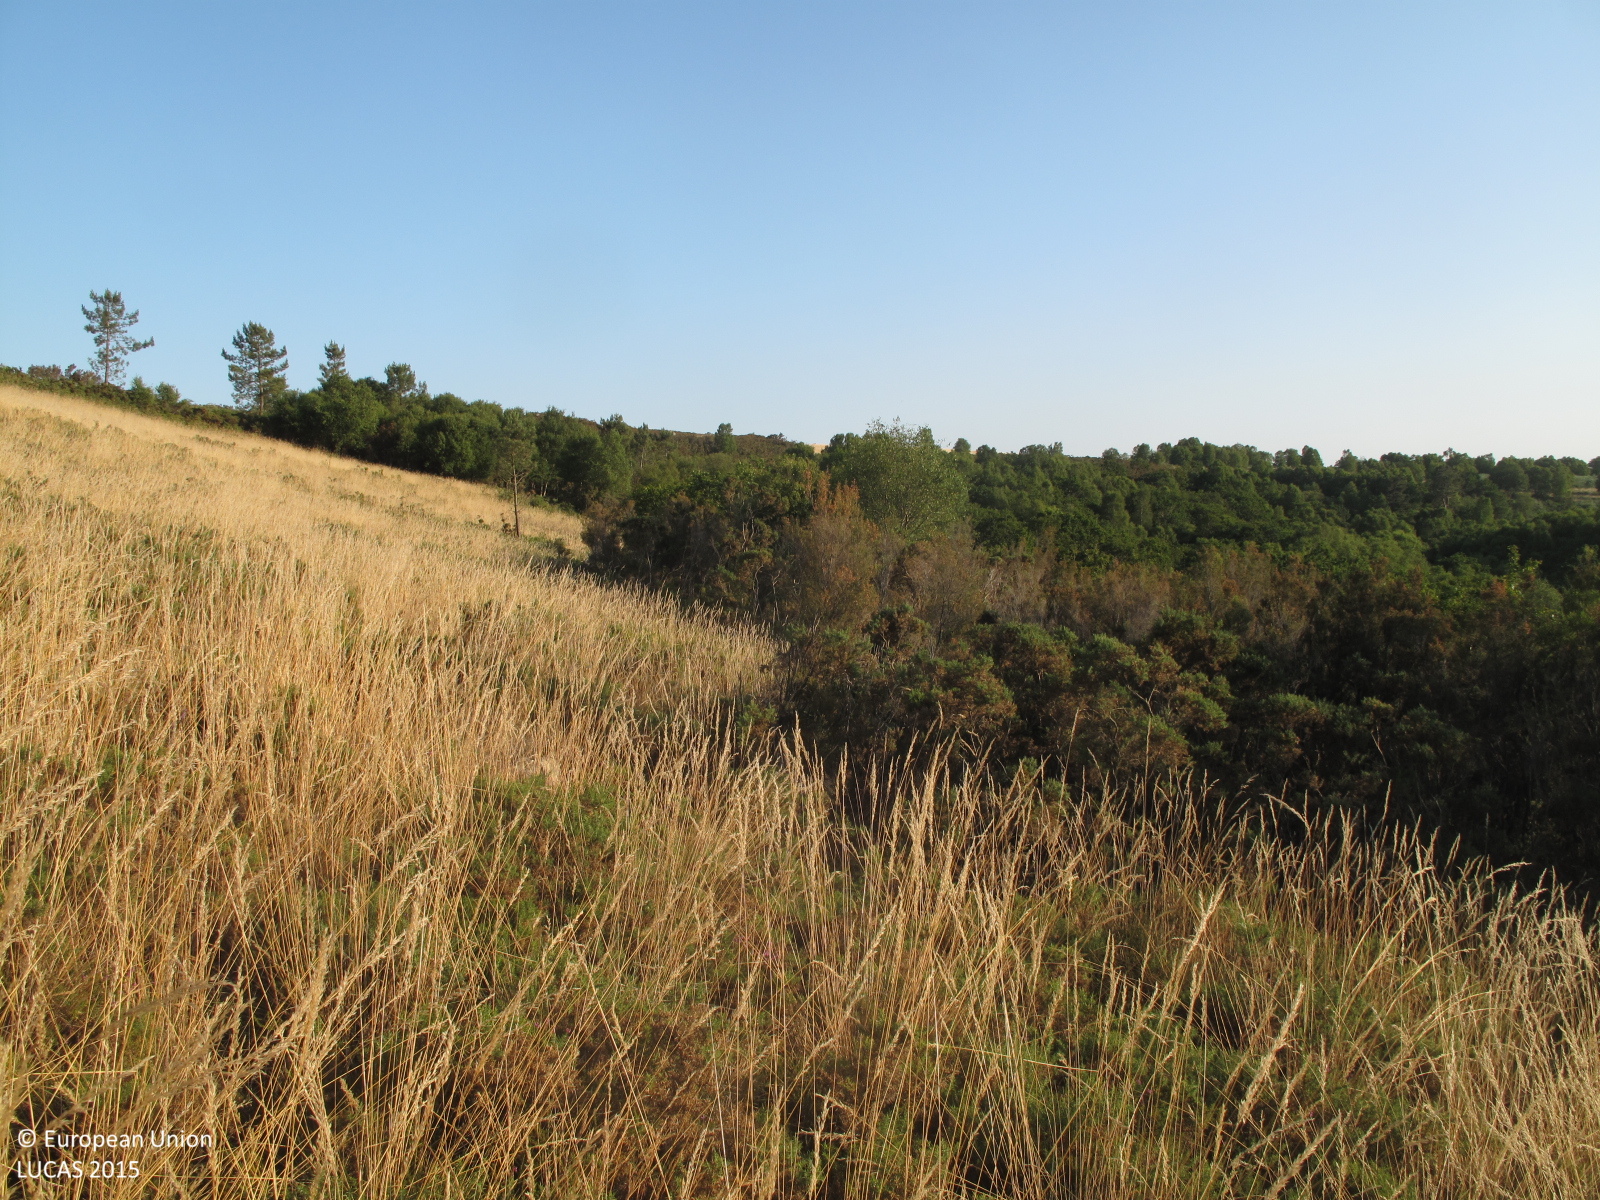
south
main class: Woodland
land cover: Broadleaved woodland
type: acidophilous oak and oak-birch forest
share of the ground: > 75 %
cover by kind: broadleaved forest trees 90 %, shrubs 10 %
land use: Semi-natural and natural areas not in use
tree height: > 5 m
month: July
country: ES
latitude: 43.4126
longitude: -7.9639
